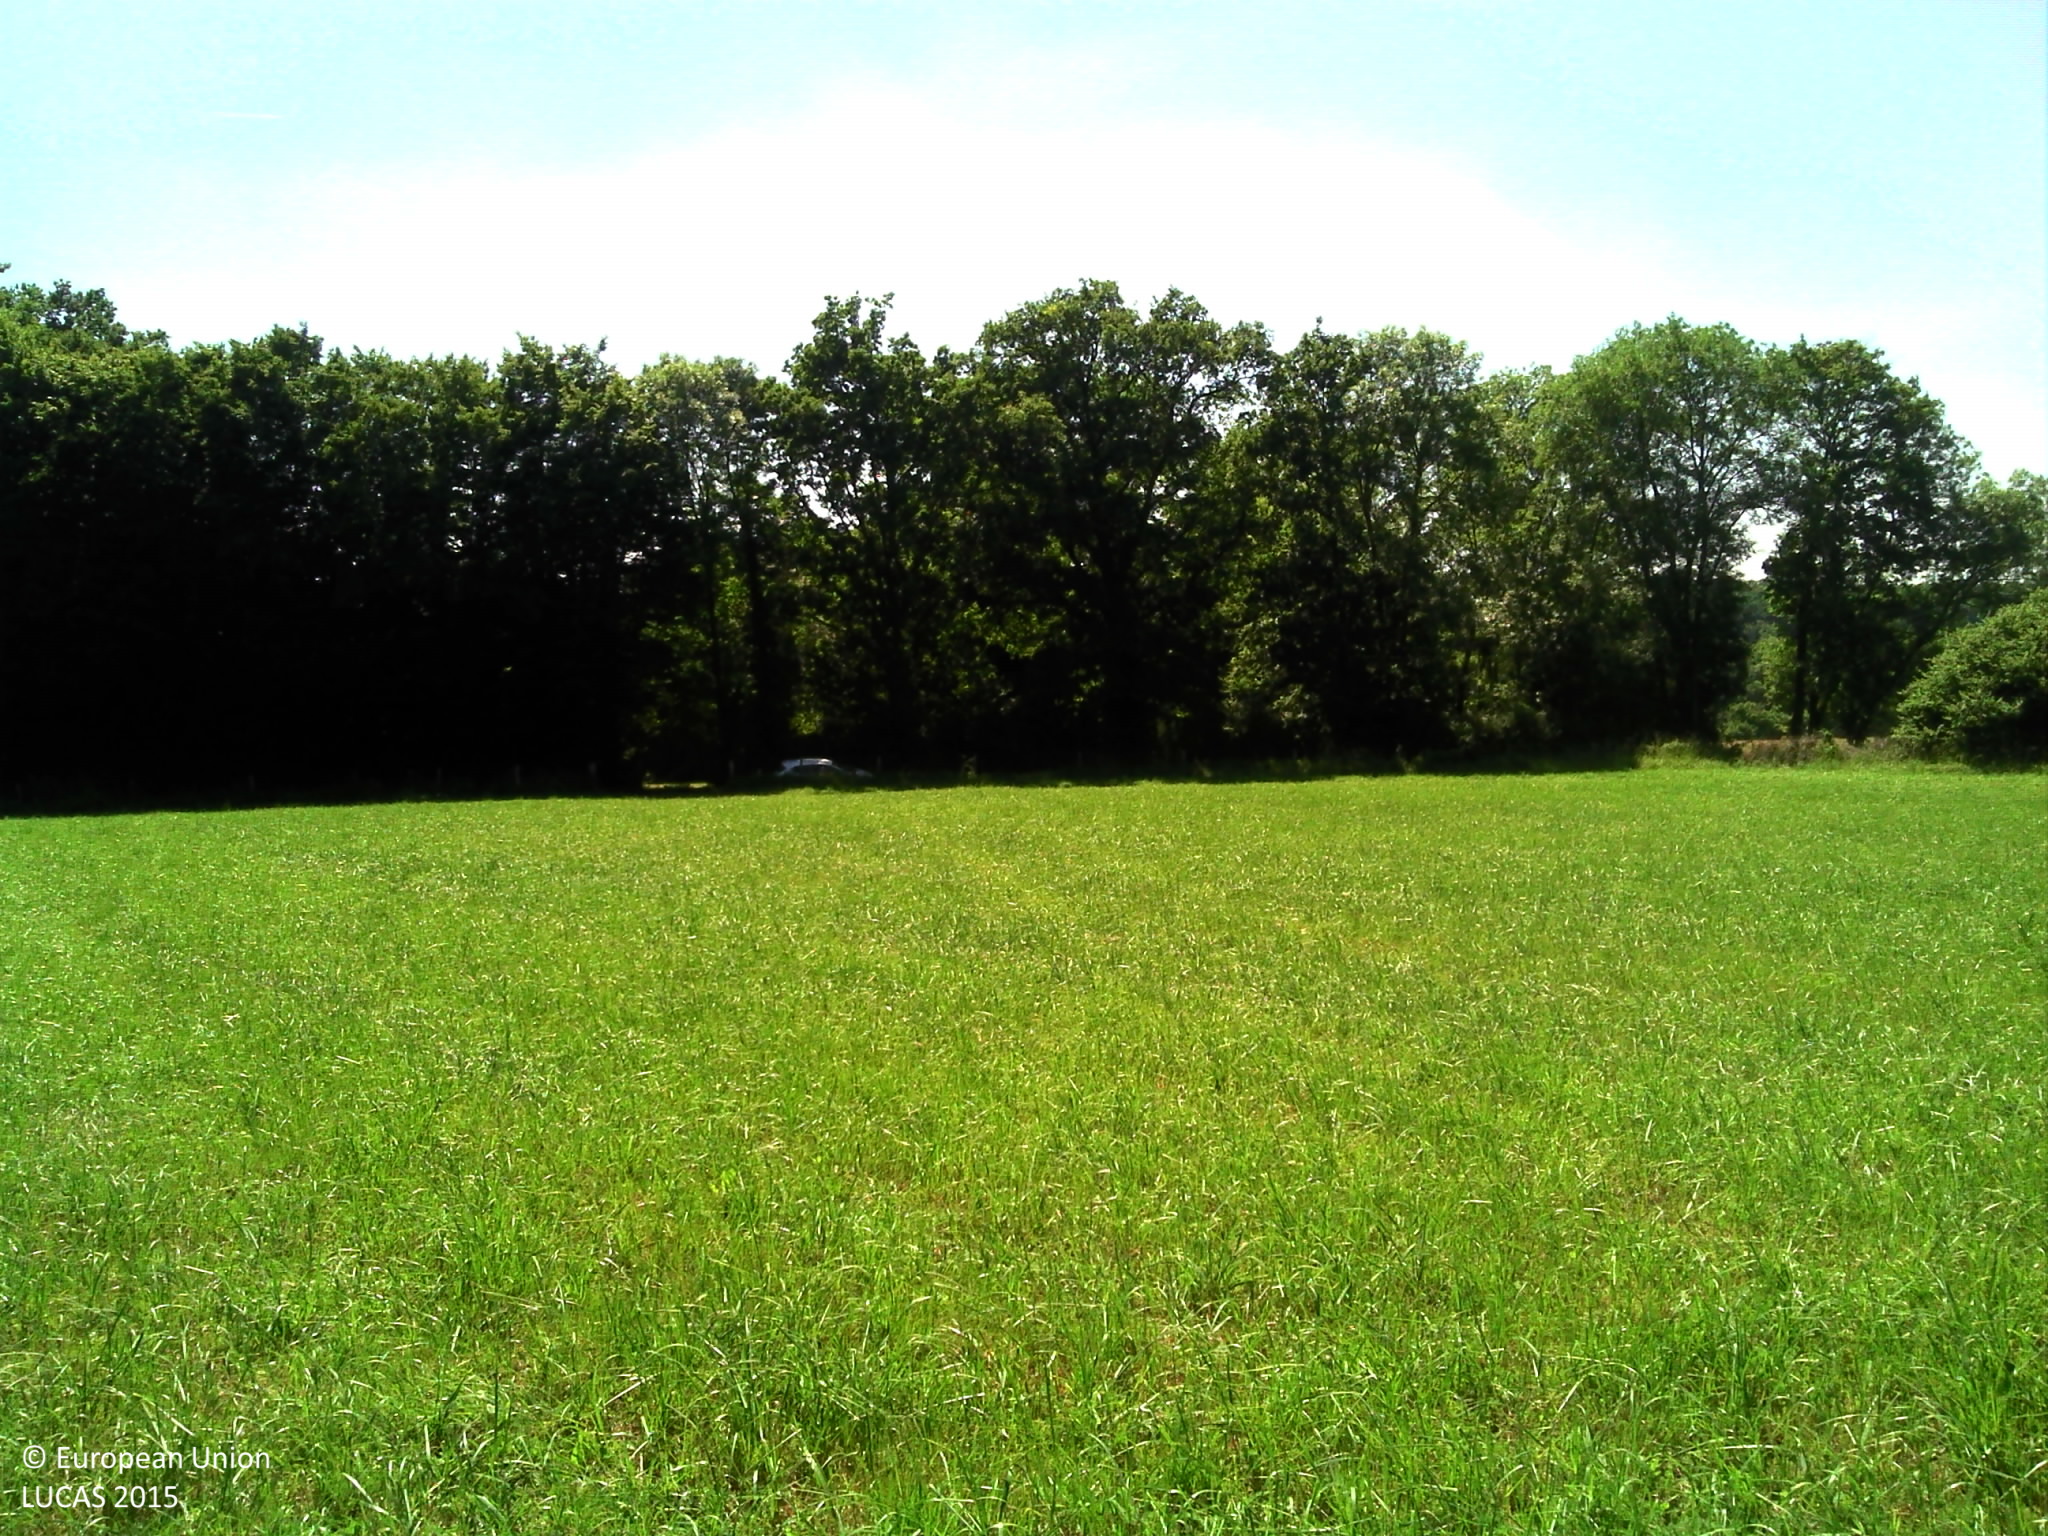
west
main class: Cropland
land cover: Temporary grasslands
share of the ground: > 75 %
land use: Agriculture (excluding fallow land and kitchen gardens)
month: June
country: FR
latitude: 45.9171
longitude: 0.5866
